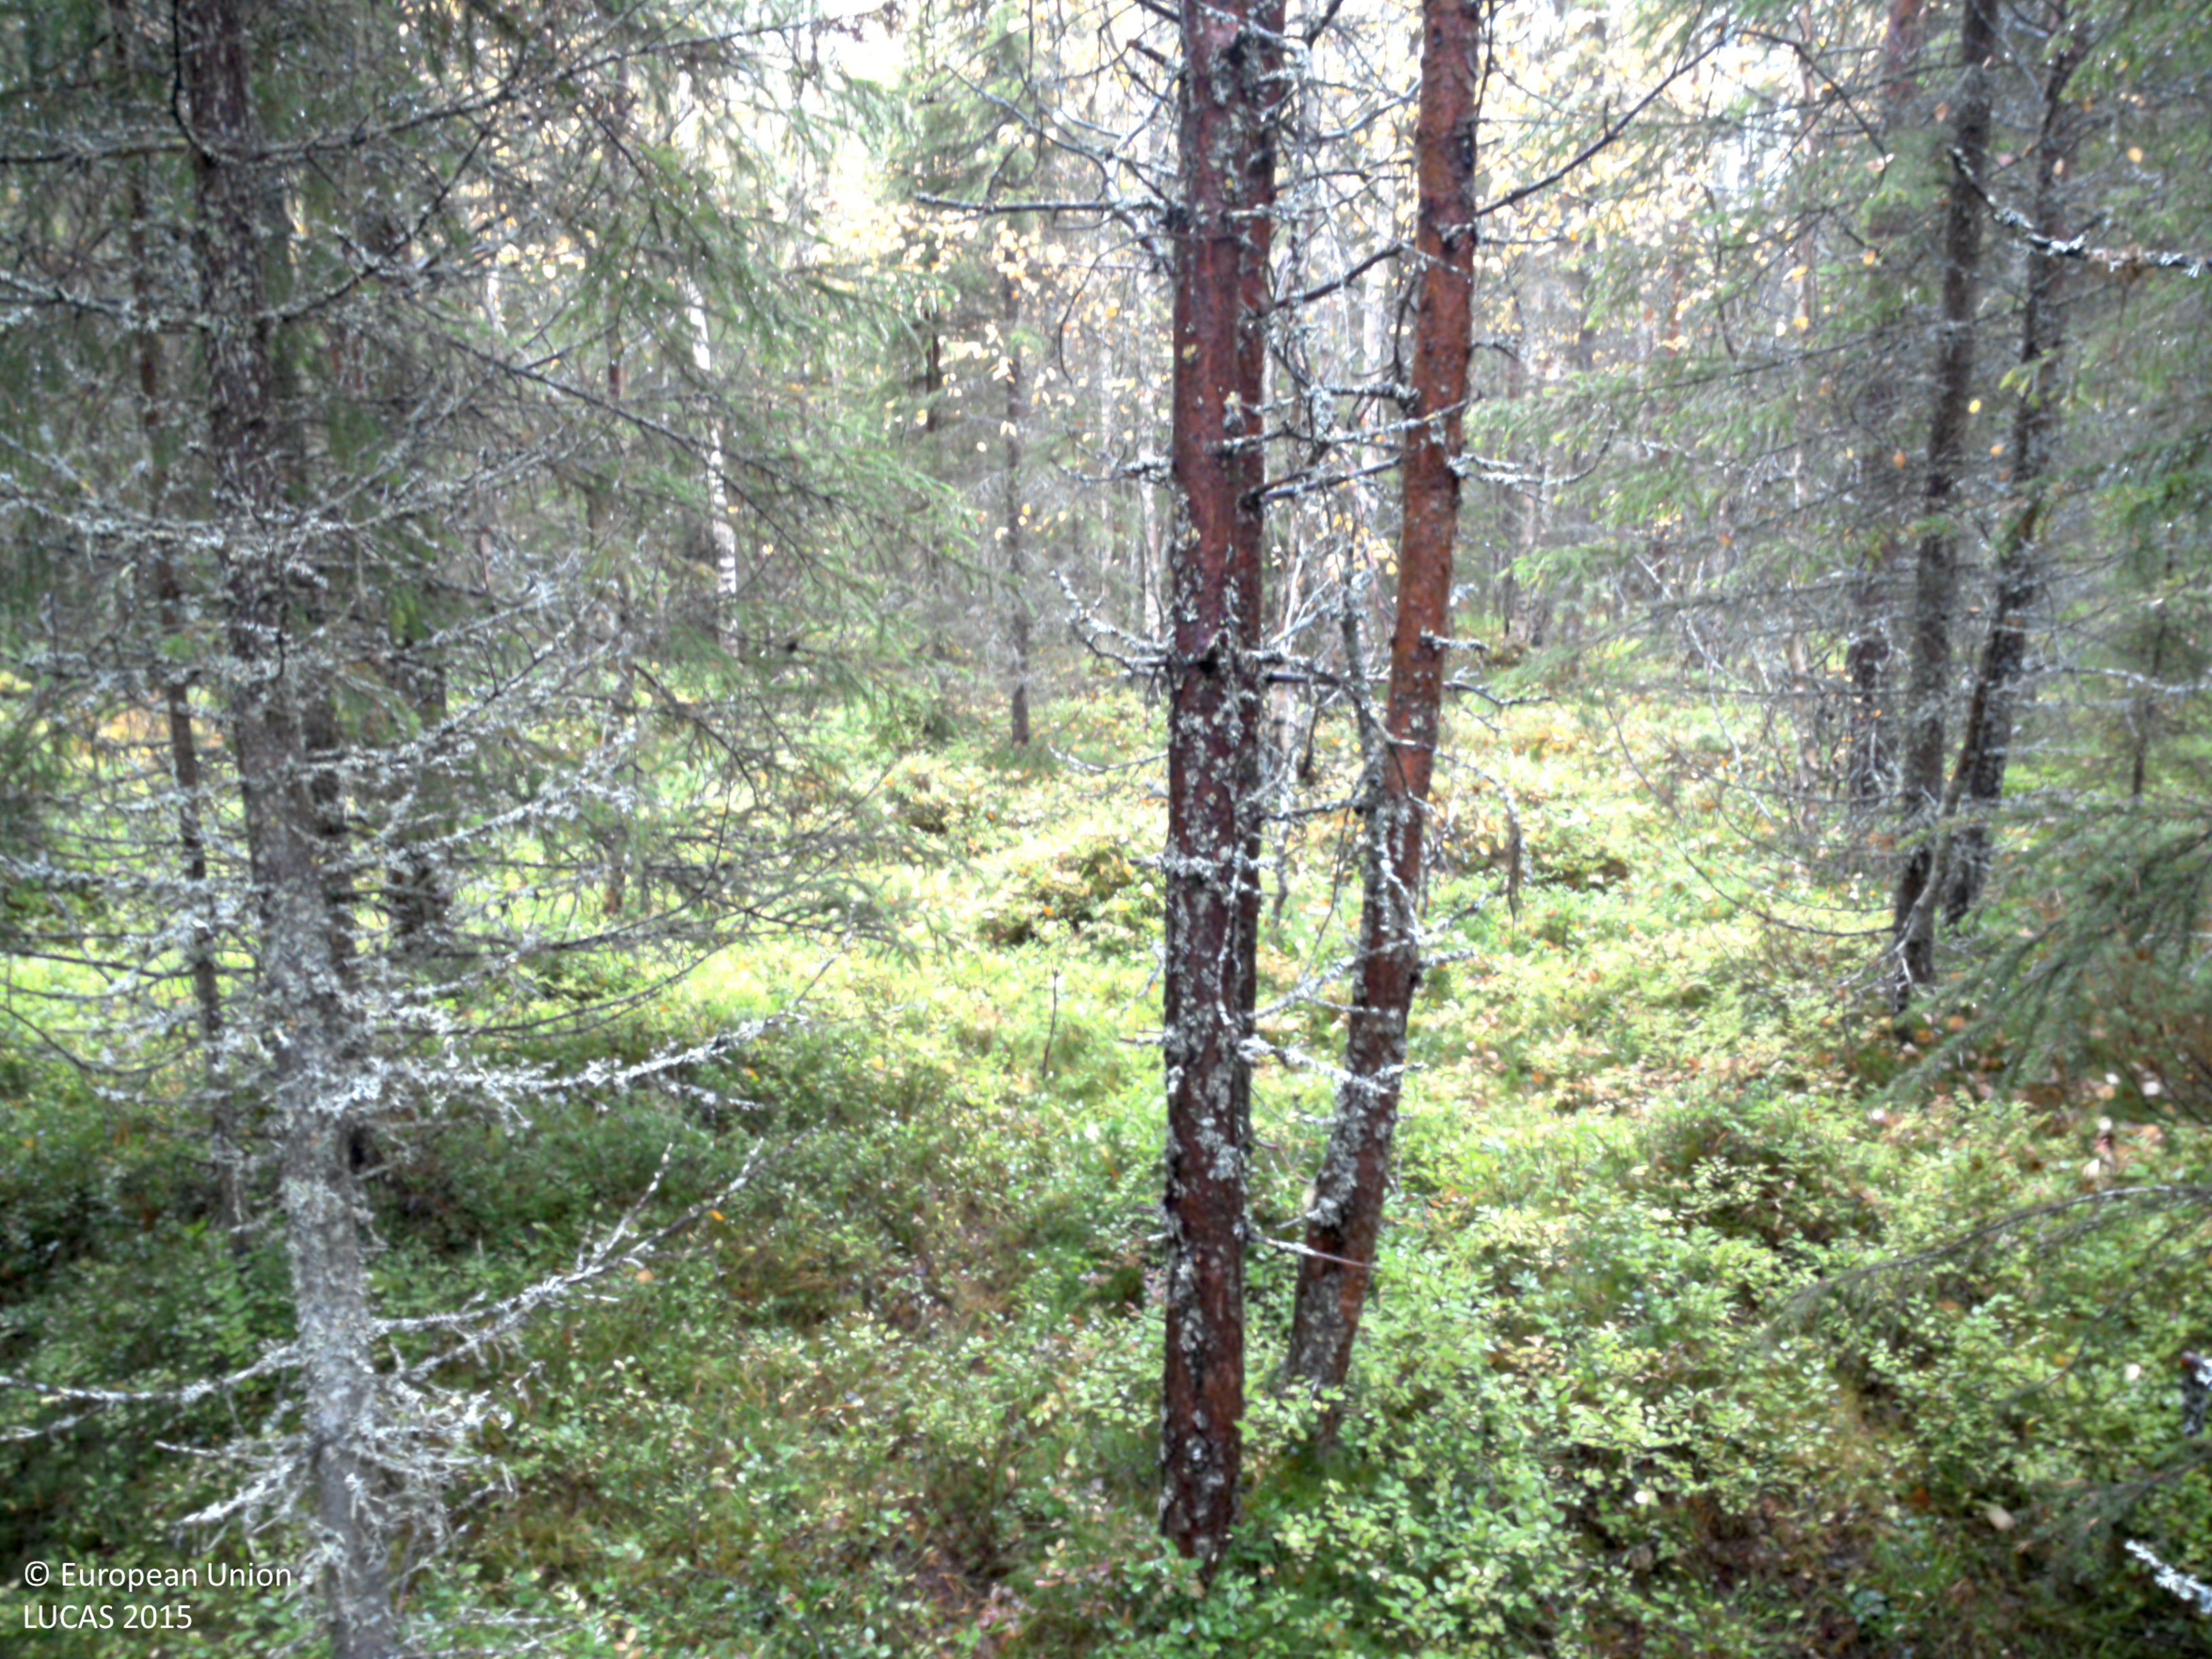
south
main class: Woodland
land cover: Pine dominated mixed woodland
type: boreal forest
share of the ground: 50 - 75 %
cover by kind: coniferous forest trees 45 %, herbaceous plants 25 %, broadleaved forest trees 15 %, shrubs 15 %
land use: Forestry
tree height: > 5 m
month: September
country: SE
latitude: 65.0169
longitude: 18.9837
